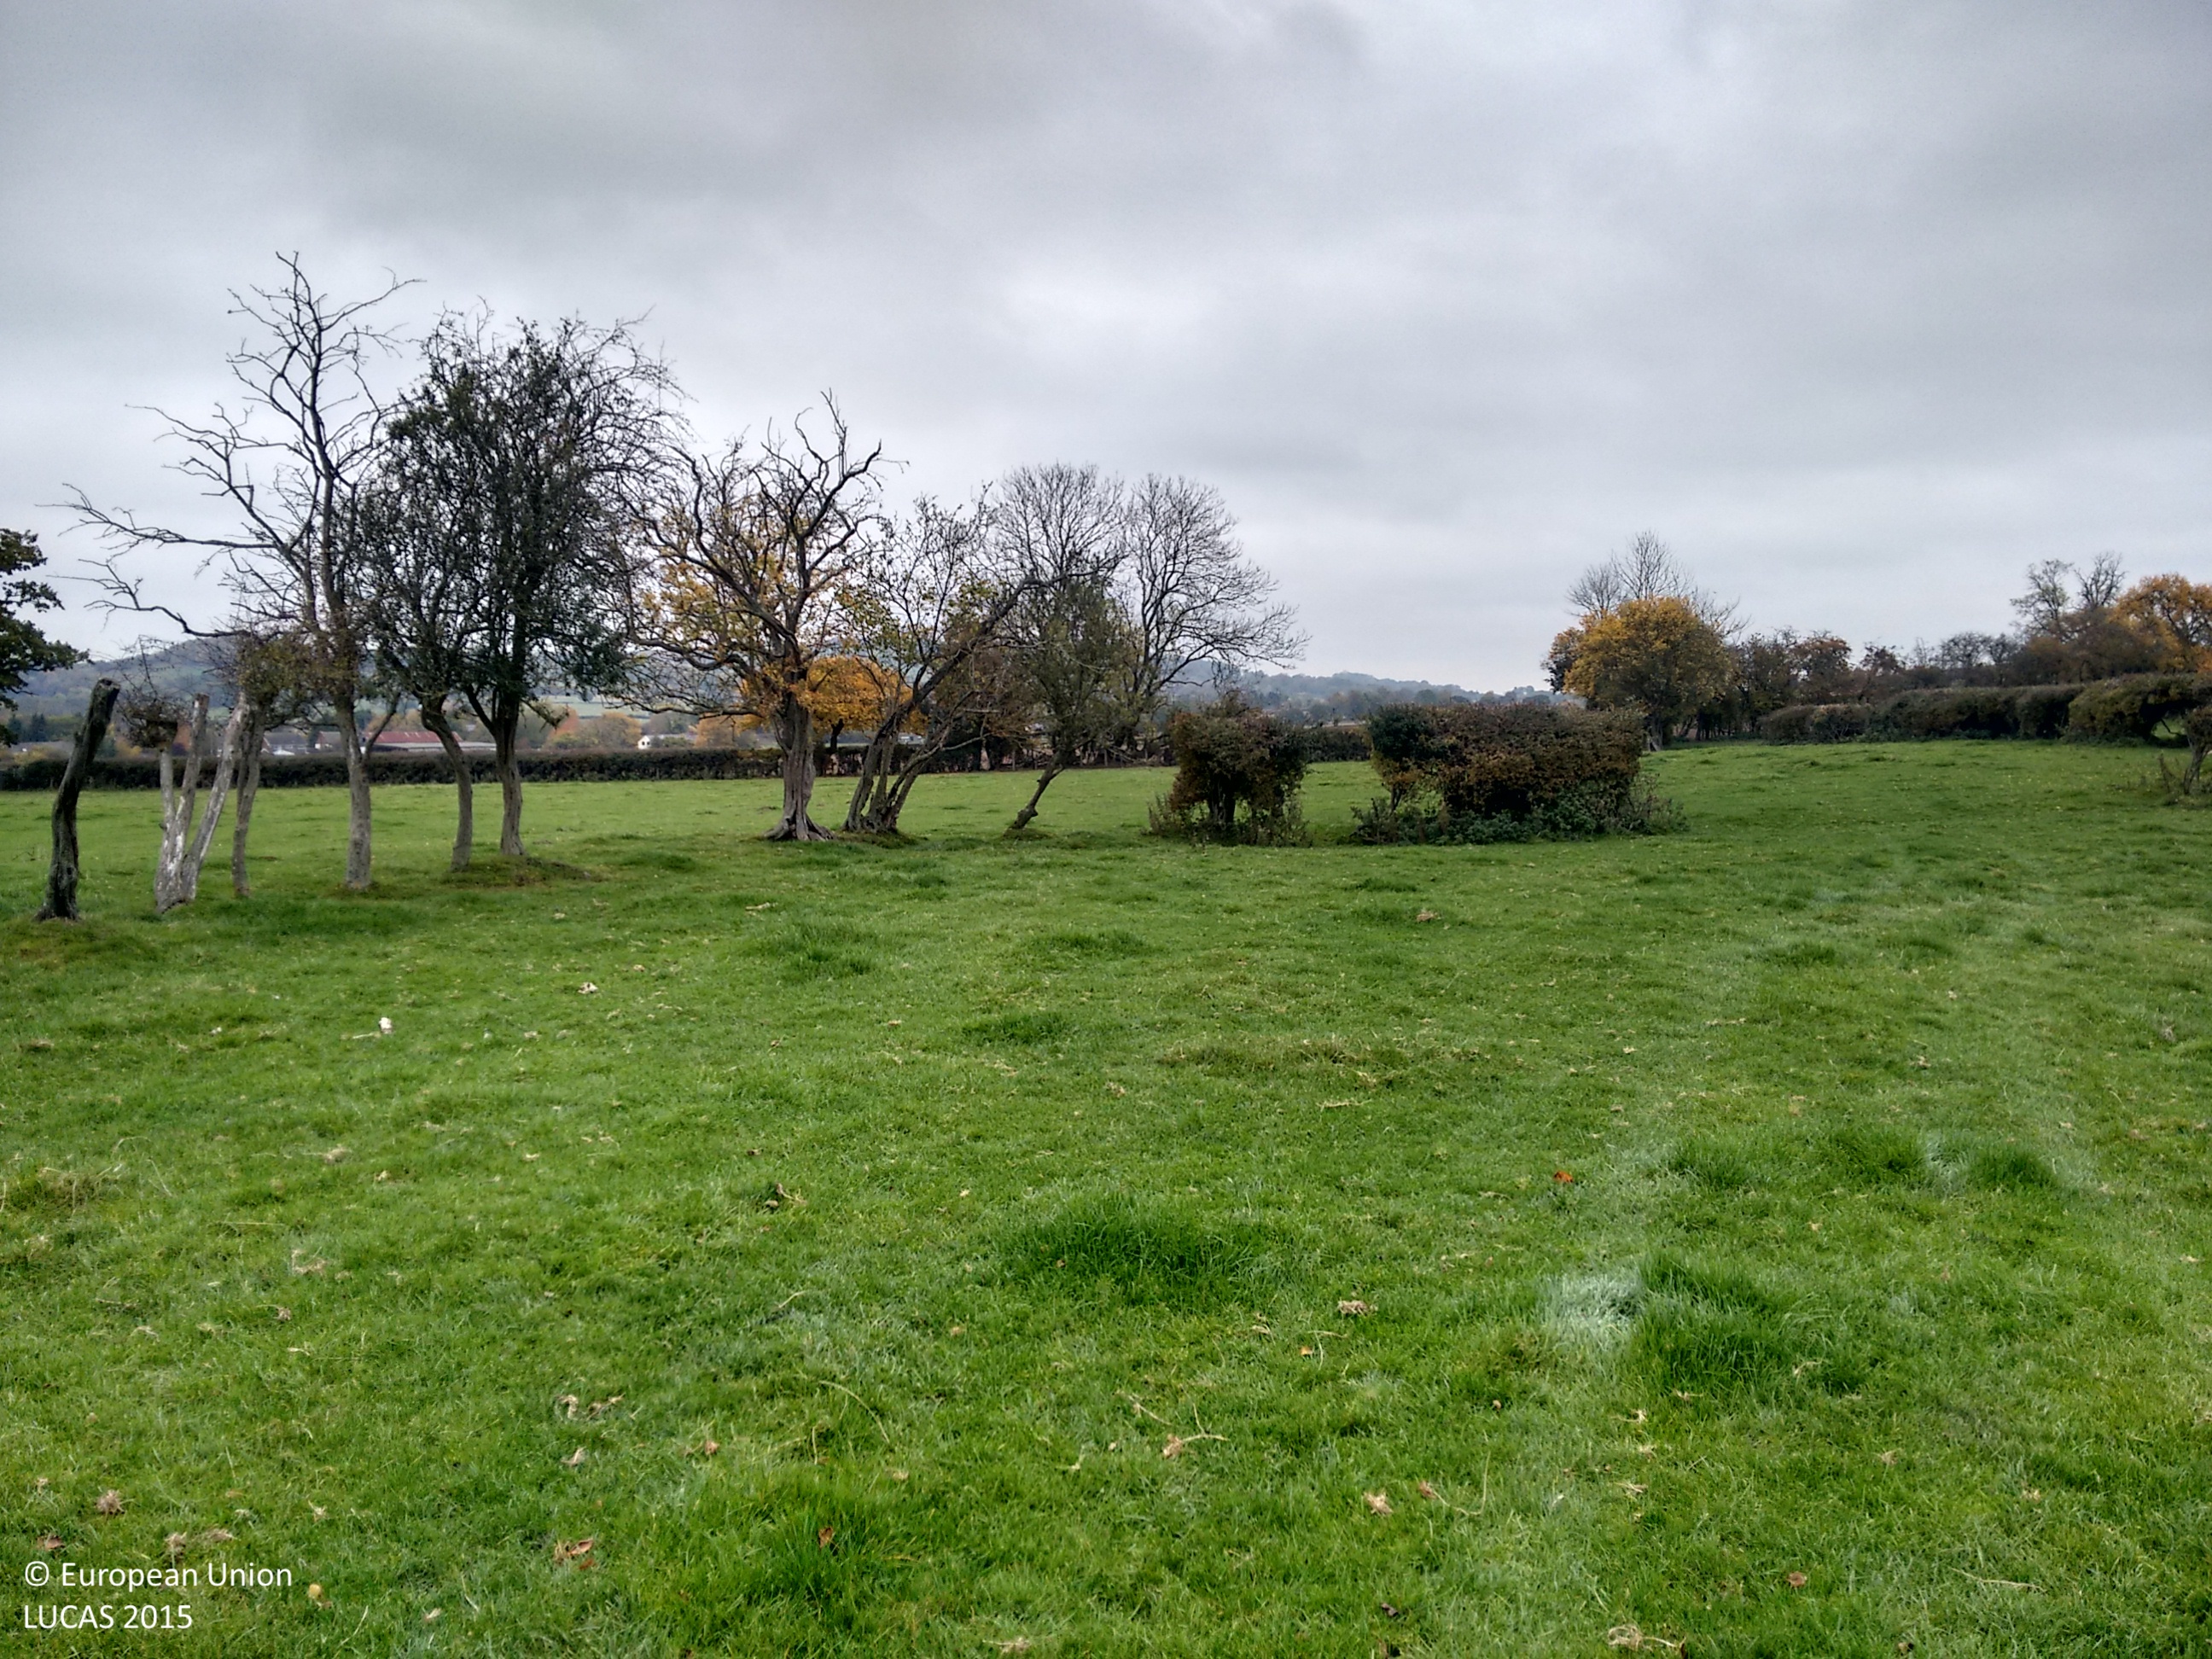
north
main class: Grassland
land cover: Grassland without tree/shrub cover
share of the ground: > 75 %
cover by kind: herbaceous plants 100 %
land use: Agriculture (excluding fallow land and kitchen gardens)
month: October
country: GB
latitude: 52.4189
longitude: -2.8798
